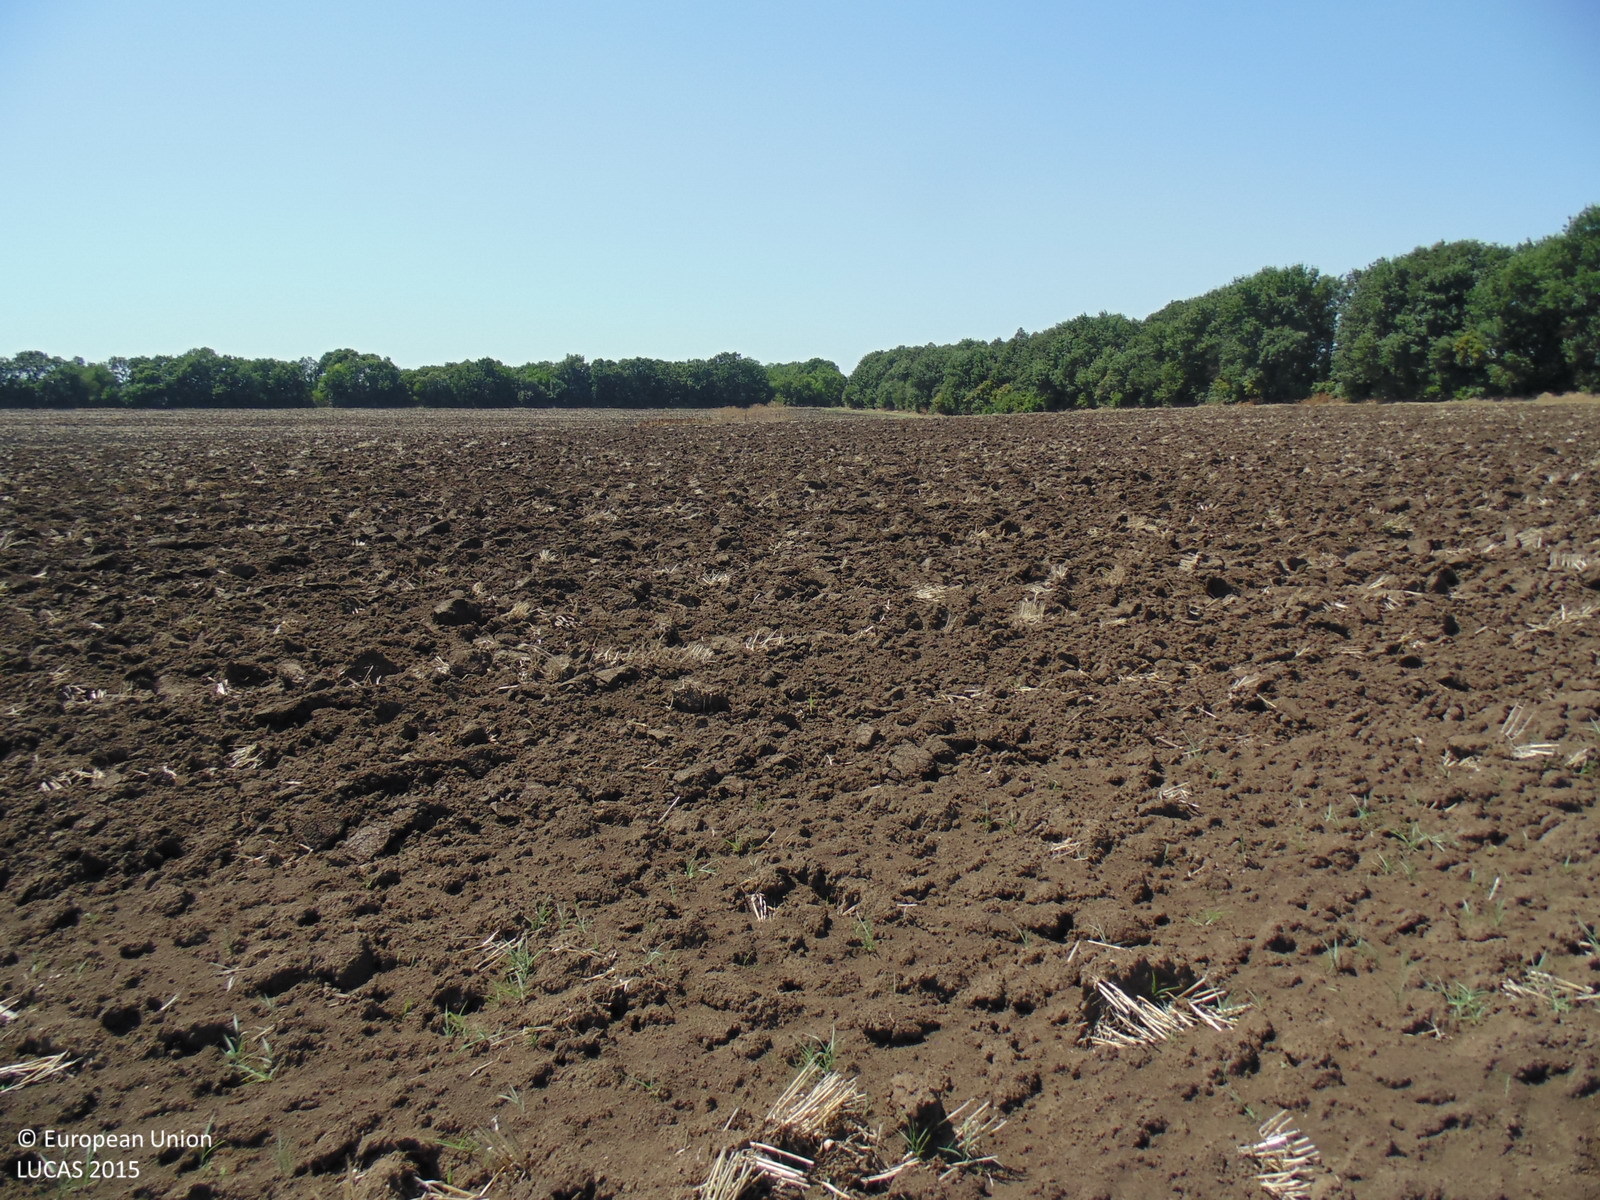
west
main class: Cropland
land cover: Common wheat
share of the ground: < 10 %
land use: Agriculture (excluding fallow land and kitchen gardens)
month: August
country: BG
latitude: 43.4827
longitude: 28.1901
